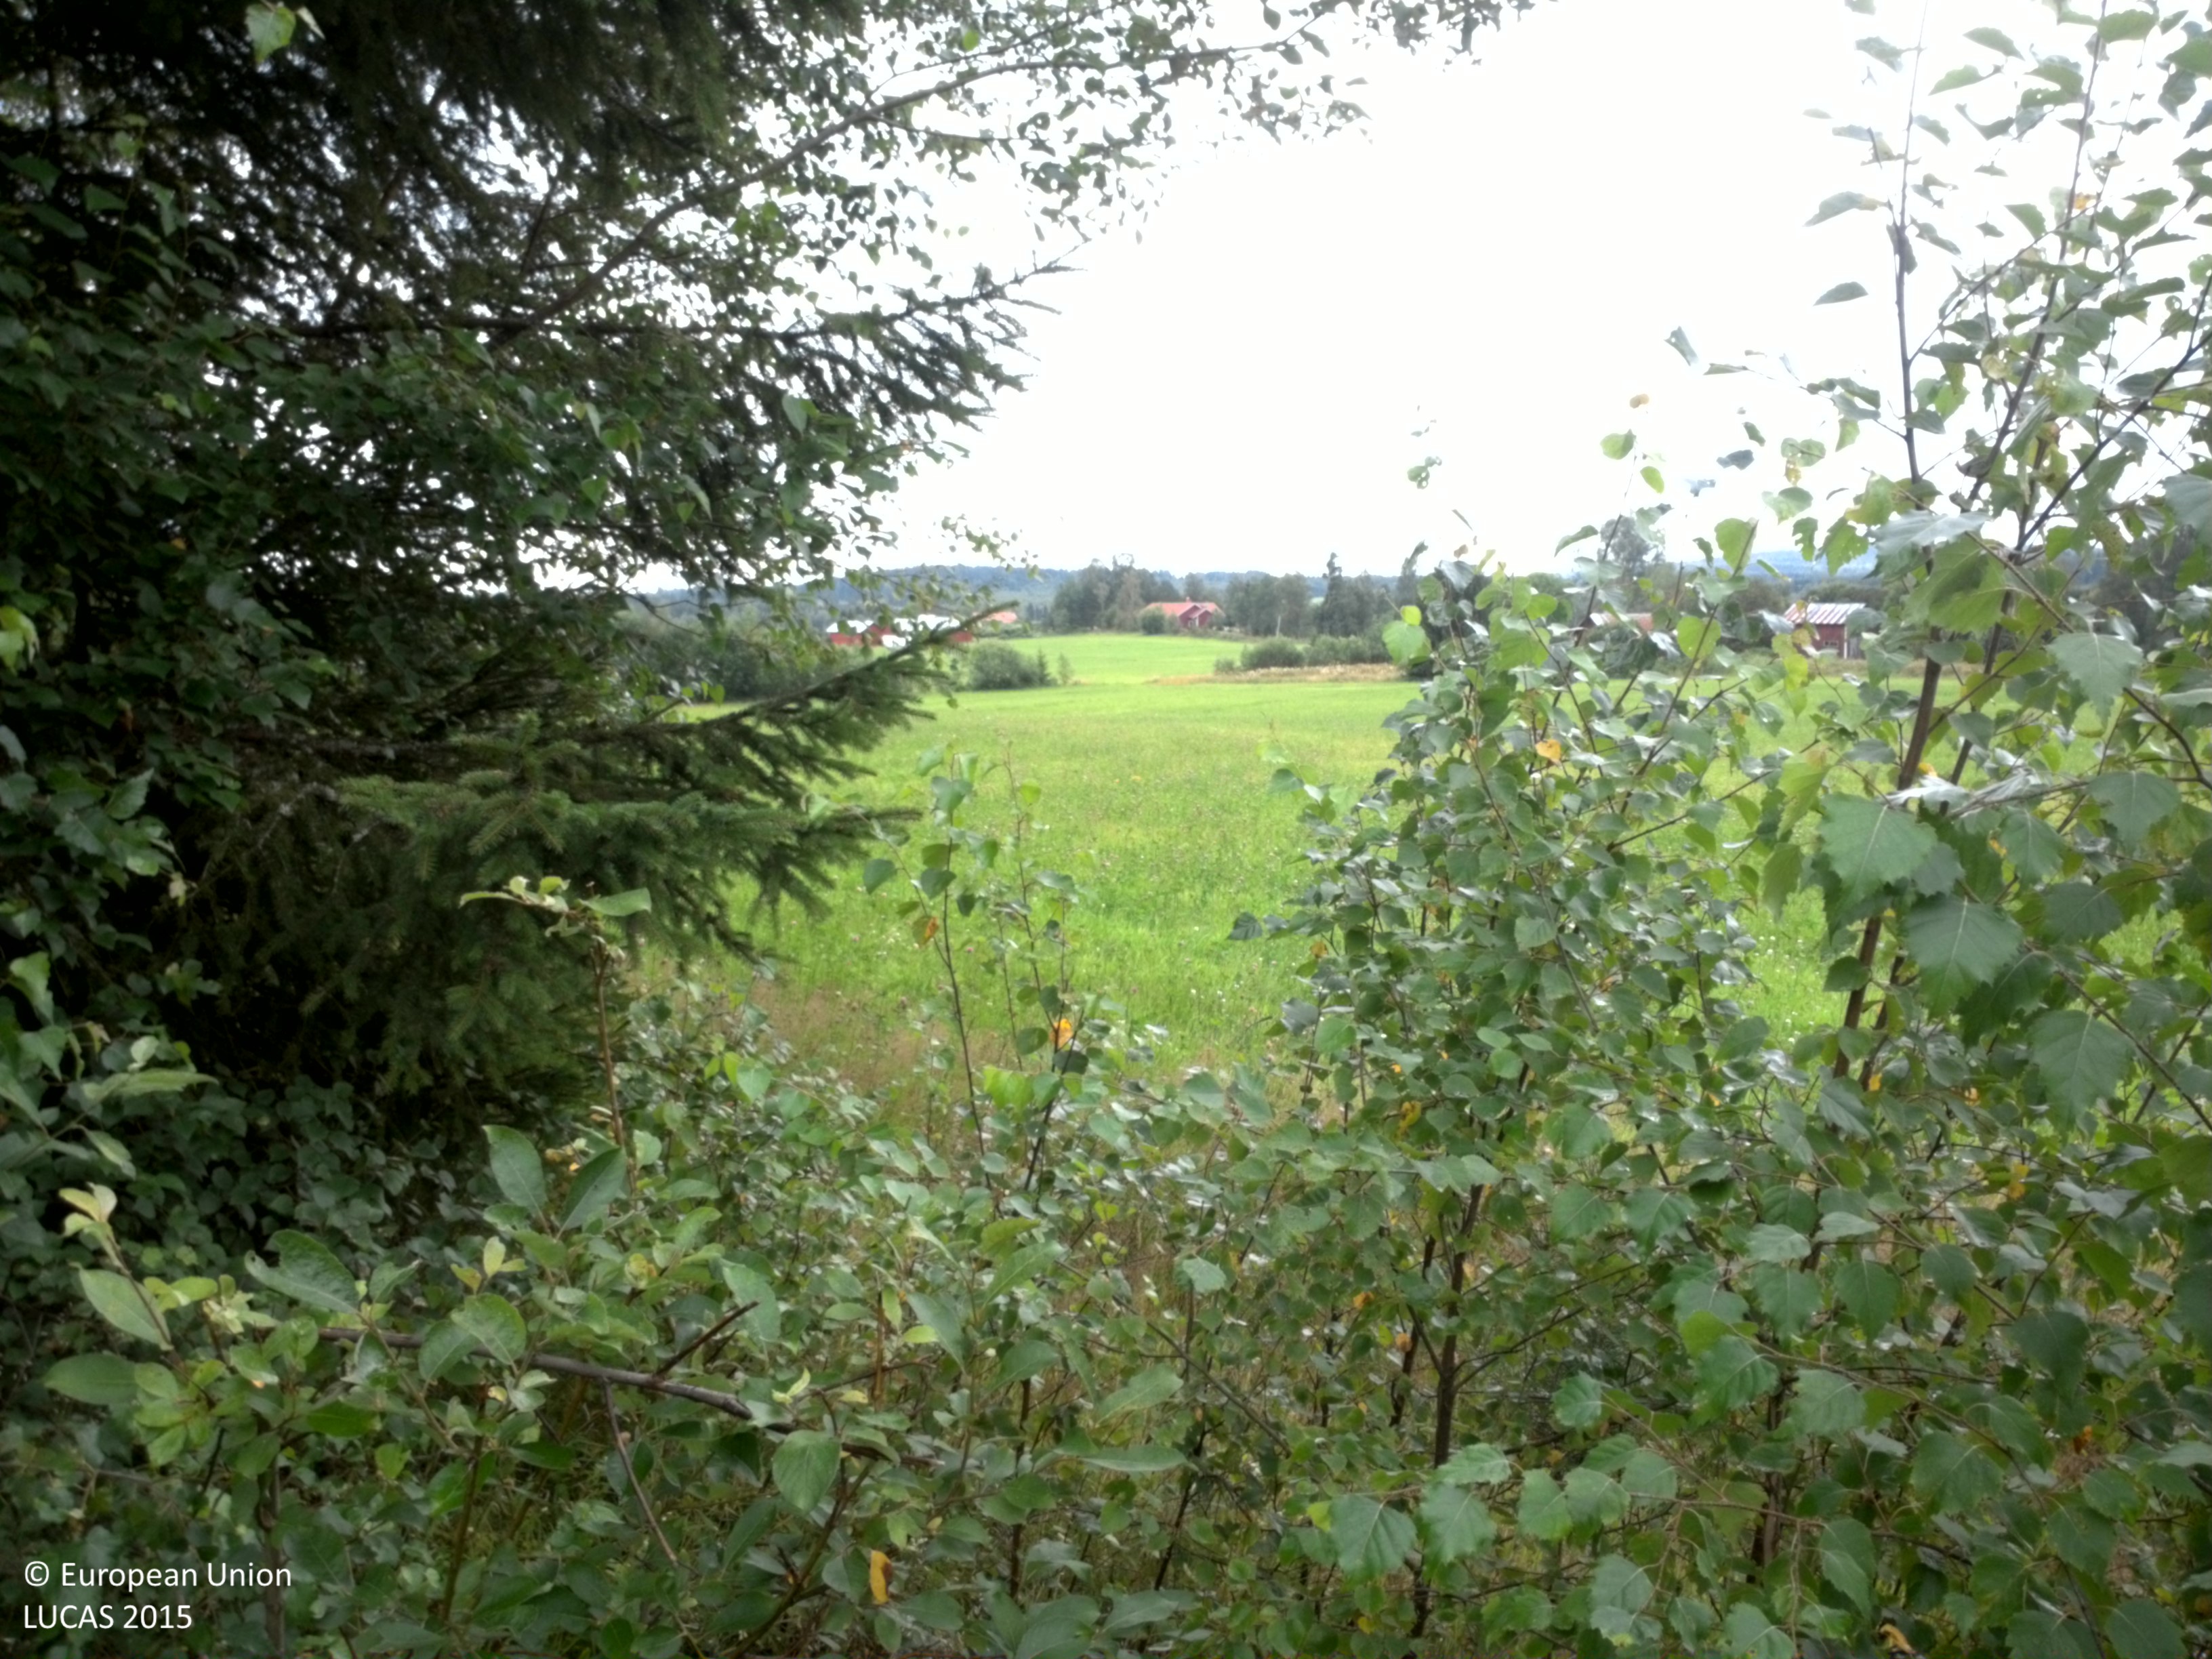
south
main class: Artificial land
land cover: Other artificial areas
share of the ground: 50 - 75 %
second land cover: Shrubland with sparse tree cover
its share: 50 - 75 %
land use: Electricity, gas and thermal power distribution
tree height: < 5 m
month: August
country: SE
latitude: 59.5843
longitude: 13.2681
